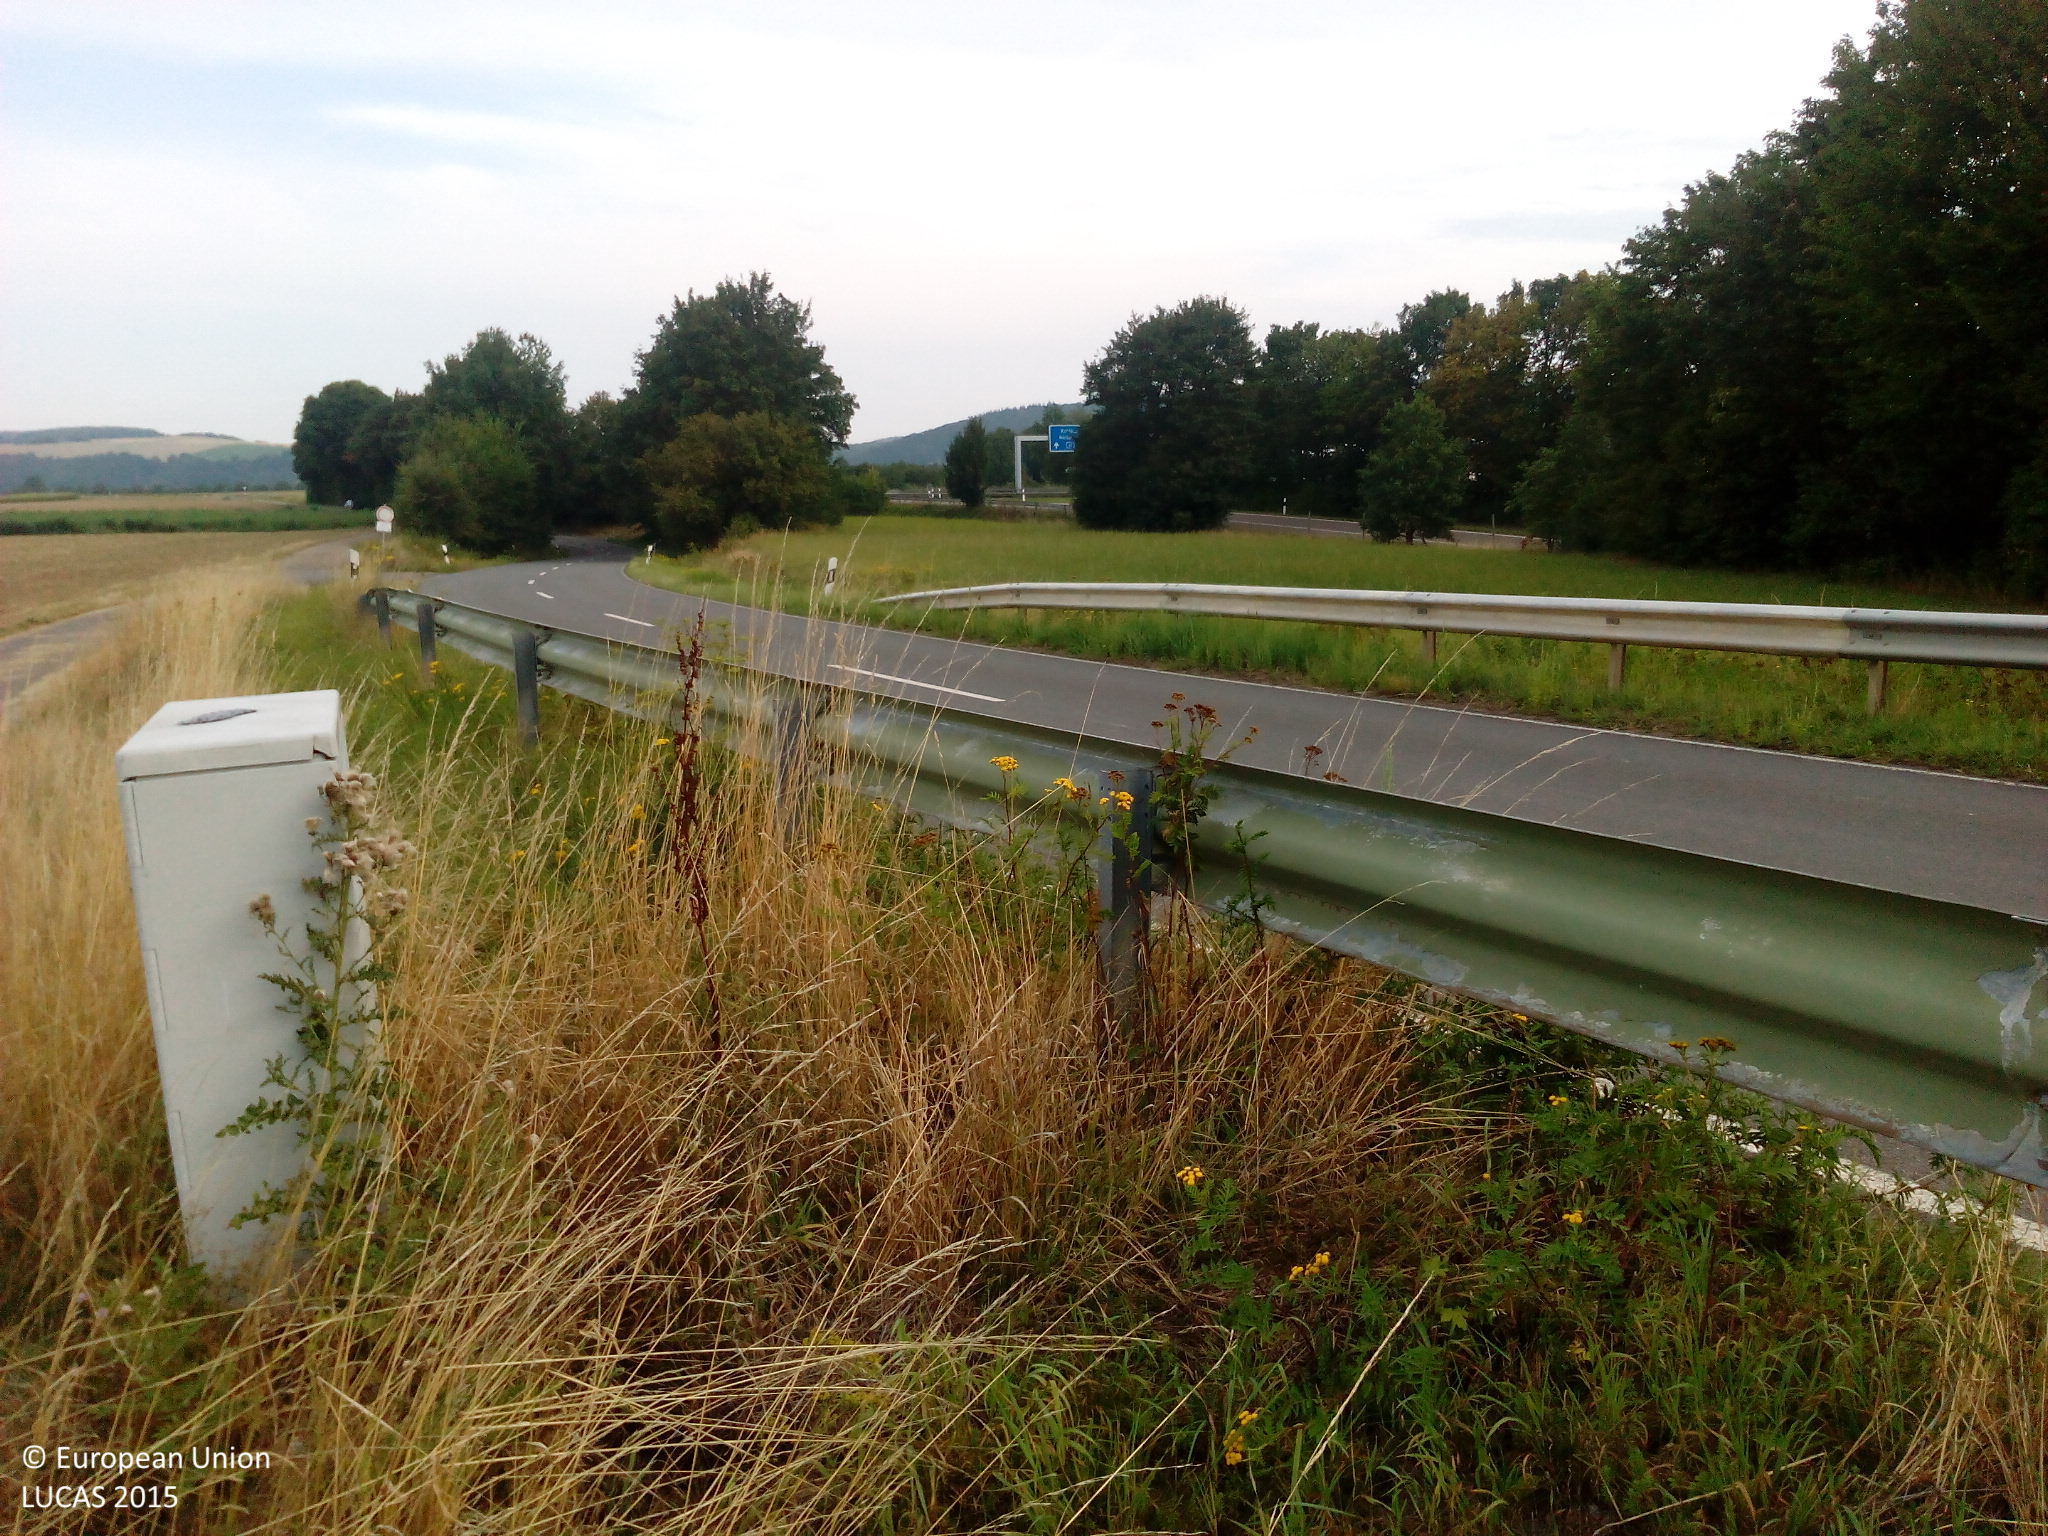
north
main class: Grassland
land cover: Grassland without tree/shrub cover
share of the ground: > 75 %
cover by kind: herbaceous plants 95 %, unconsolidated bare surface 5 %
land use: Road transport
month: August
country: DE
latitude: 50.3005
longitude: 7.4873
